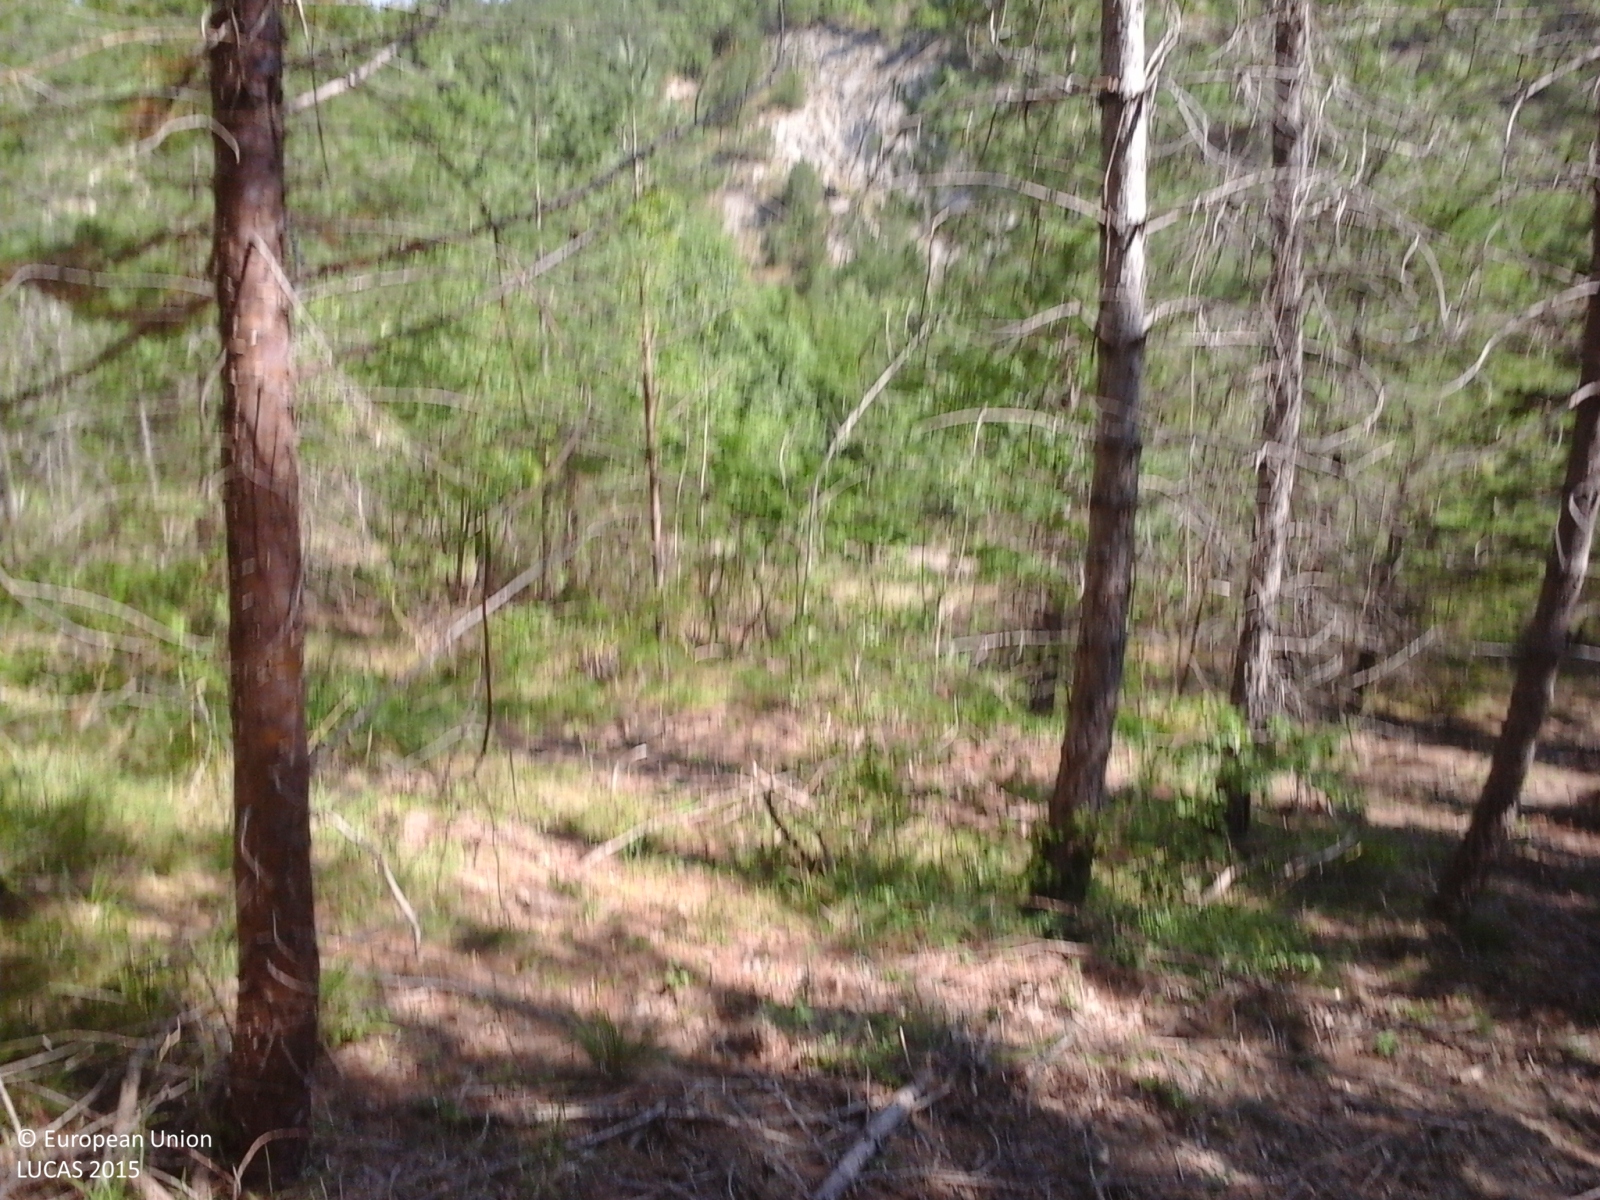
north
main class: Woodland
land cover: Pine dominated mixed woodland
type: coniferous forest of the mediterranean region
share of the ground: 50 - 75 %
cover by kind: coniferous forest trees 60 %, broadleaved forest trees 20 %, shrubs 10 %, herbaceous plants 10 %
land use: Forestry
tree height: > 5 m
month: July
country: IT
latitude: 42.9488
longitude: 11.5762
